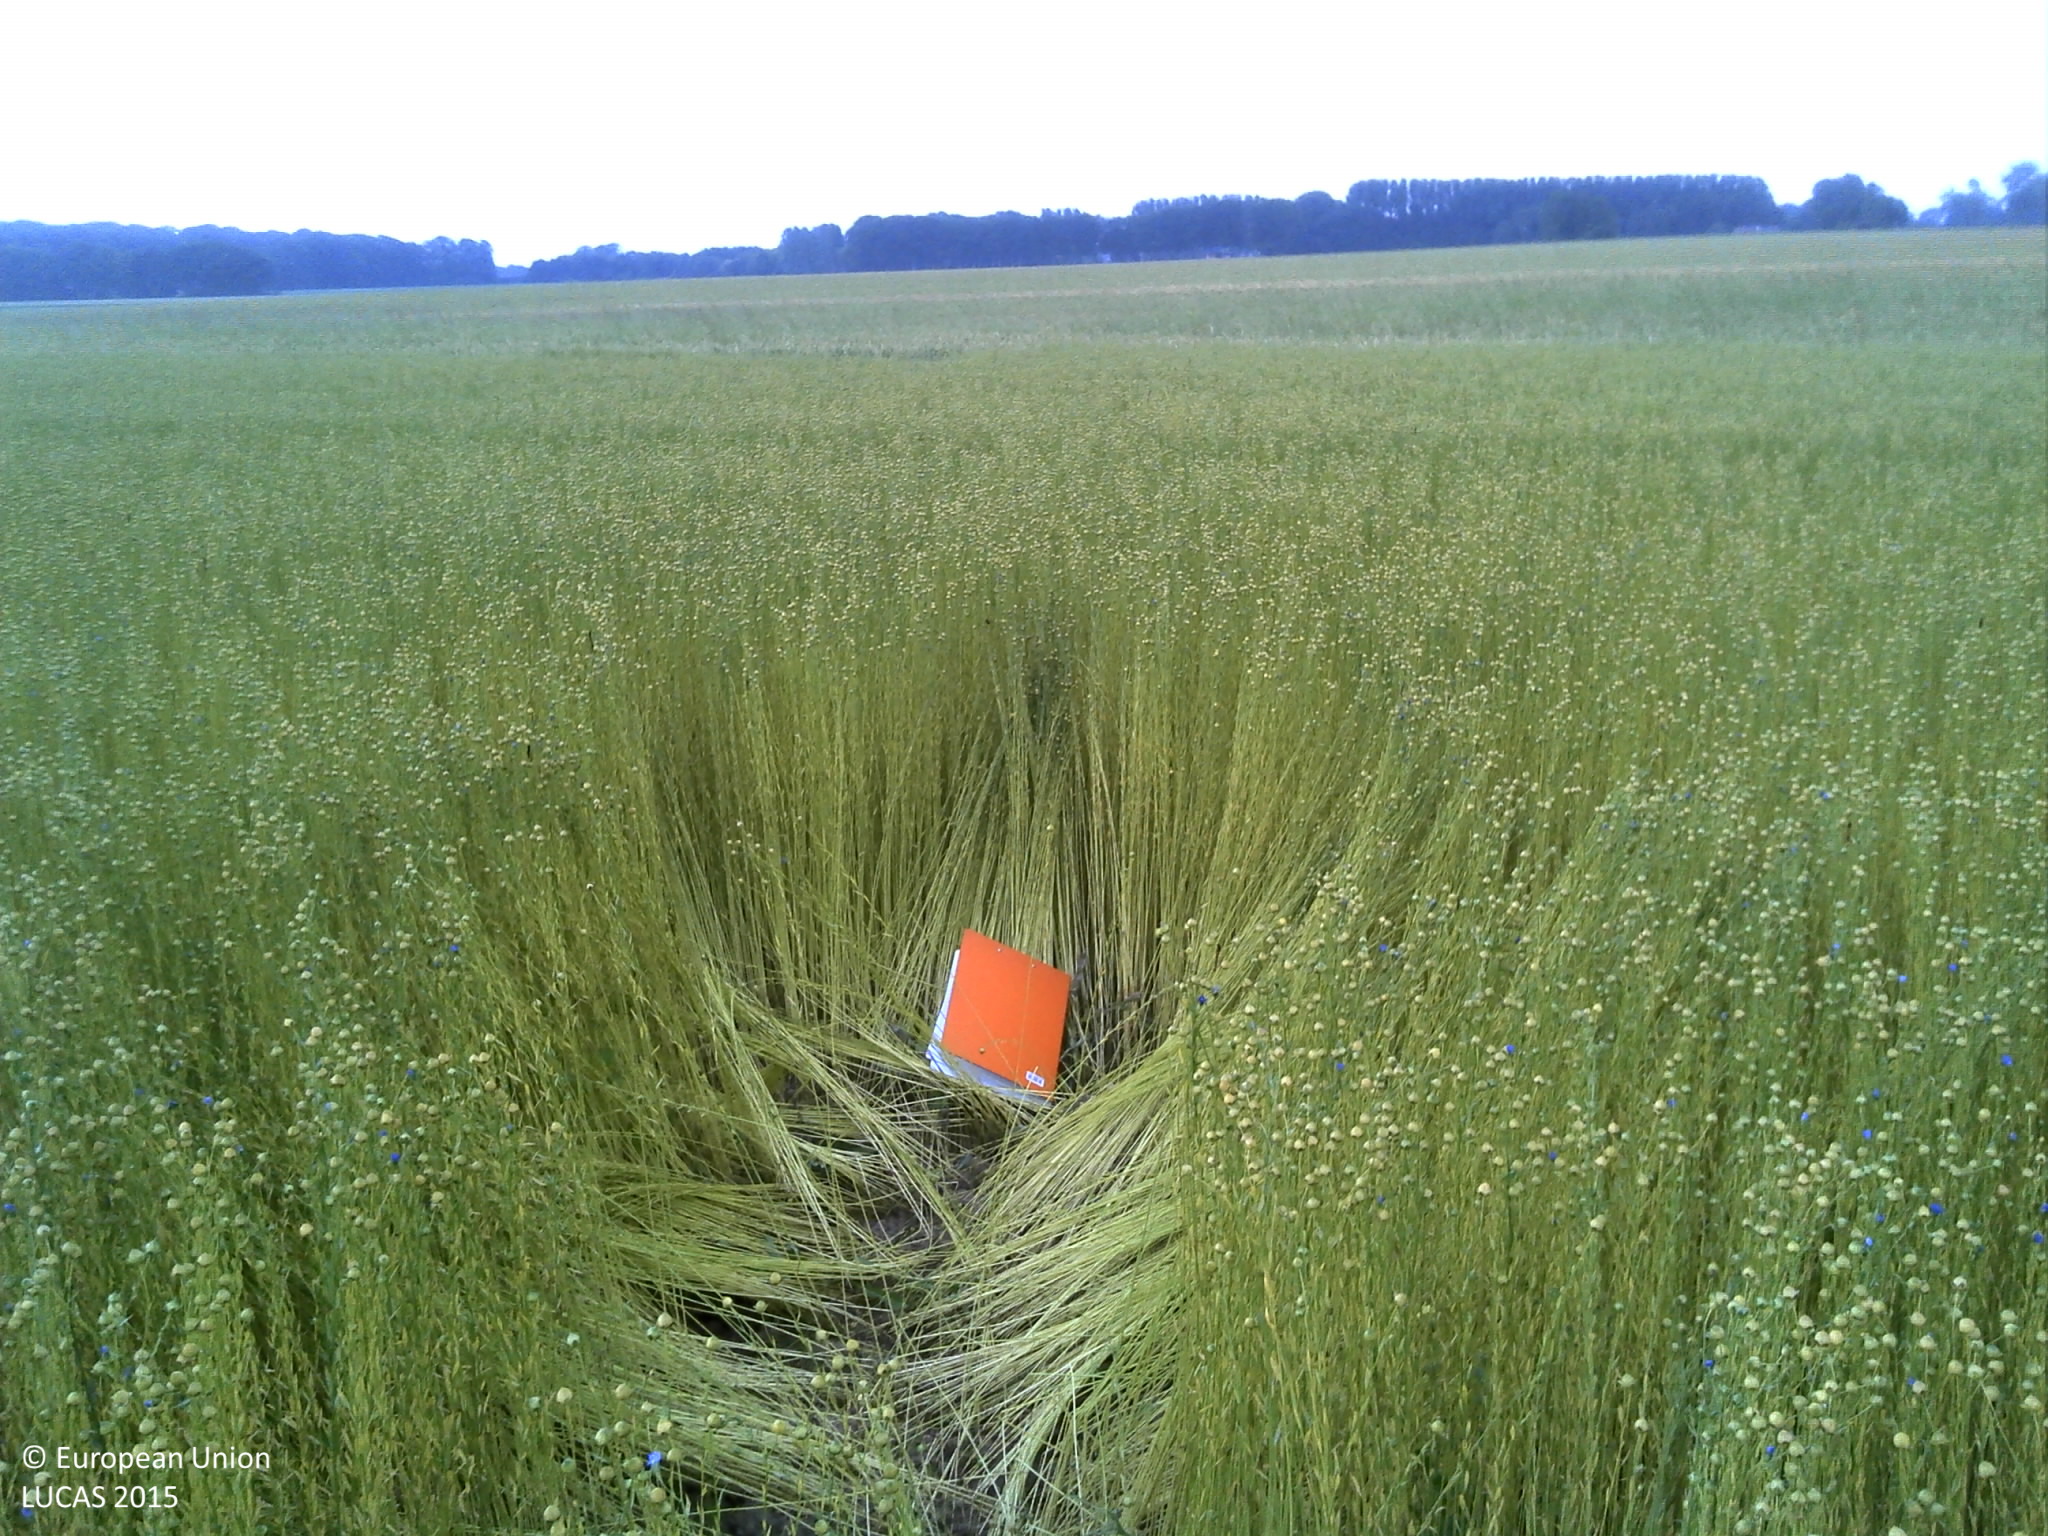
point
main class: Cropland
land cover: Other fibre and oleaginous crops
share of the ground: > 75 %
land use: Agriculture (excluding fallow land and kitchen gardens)
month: July
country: FR
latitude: 49.8843
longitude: 1.0285
